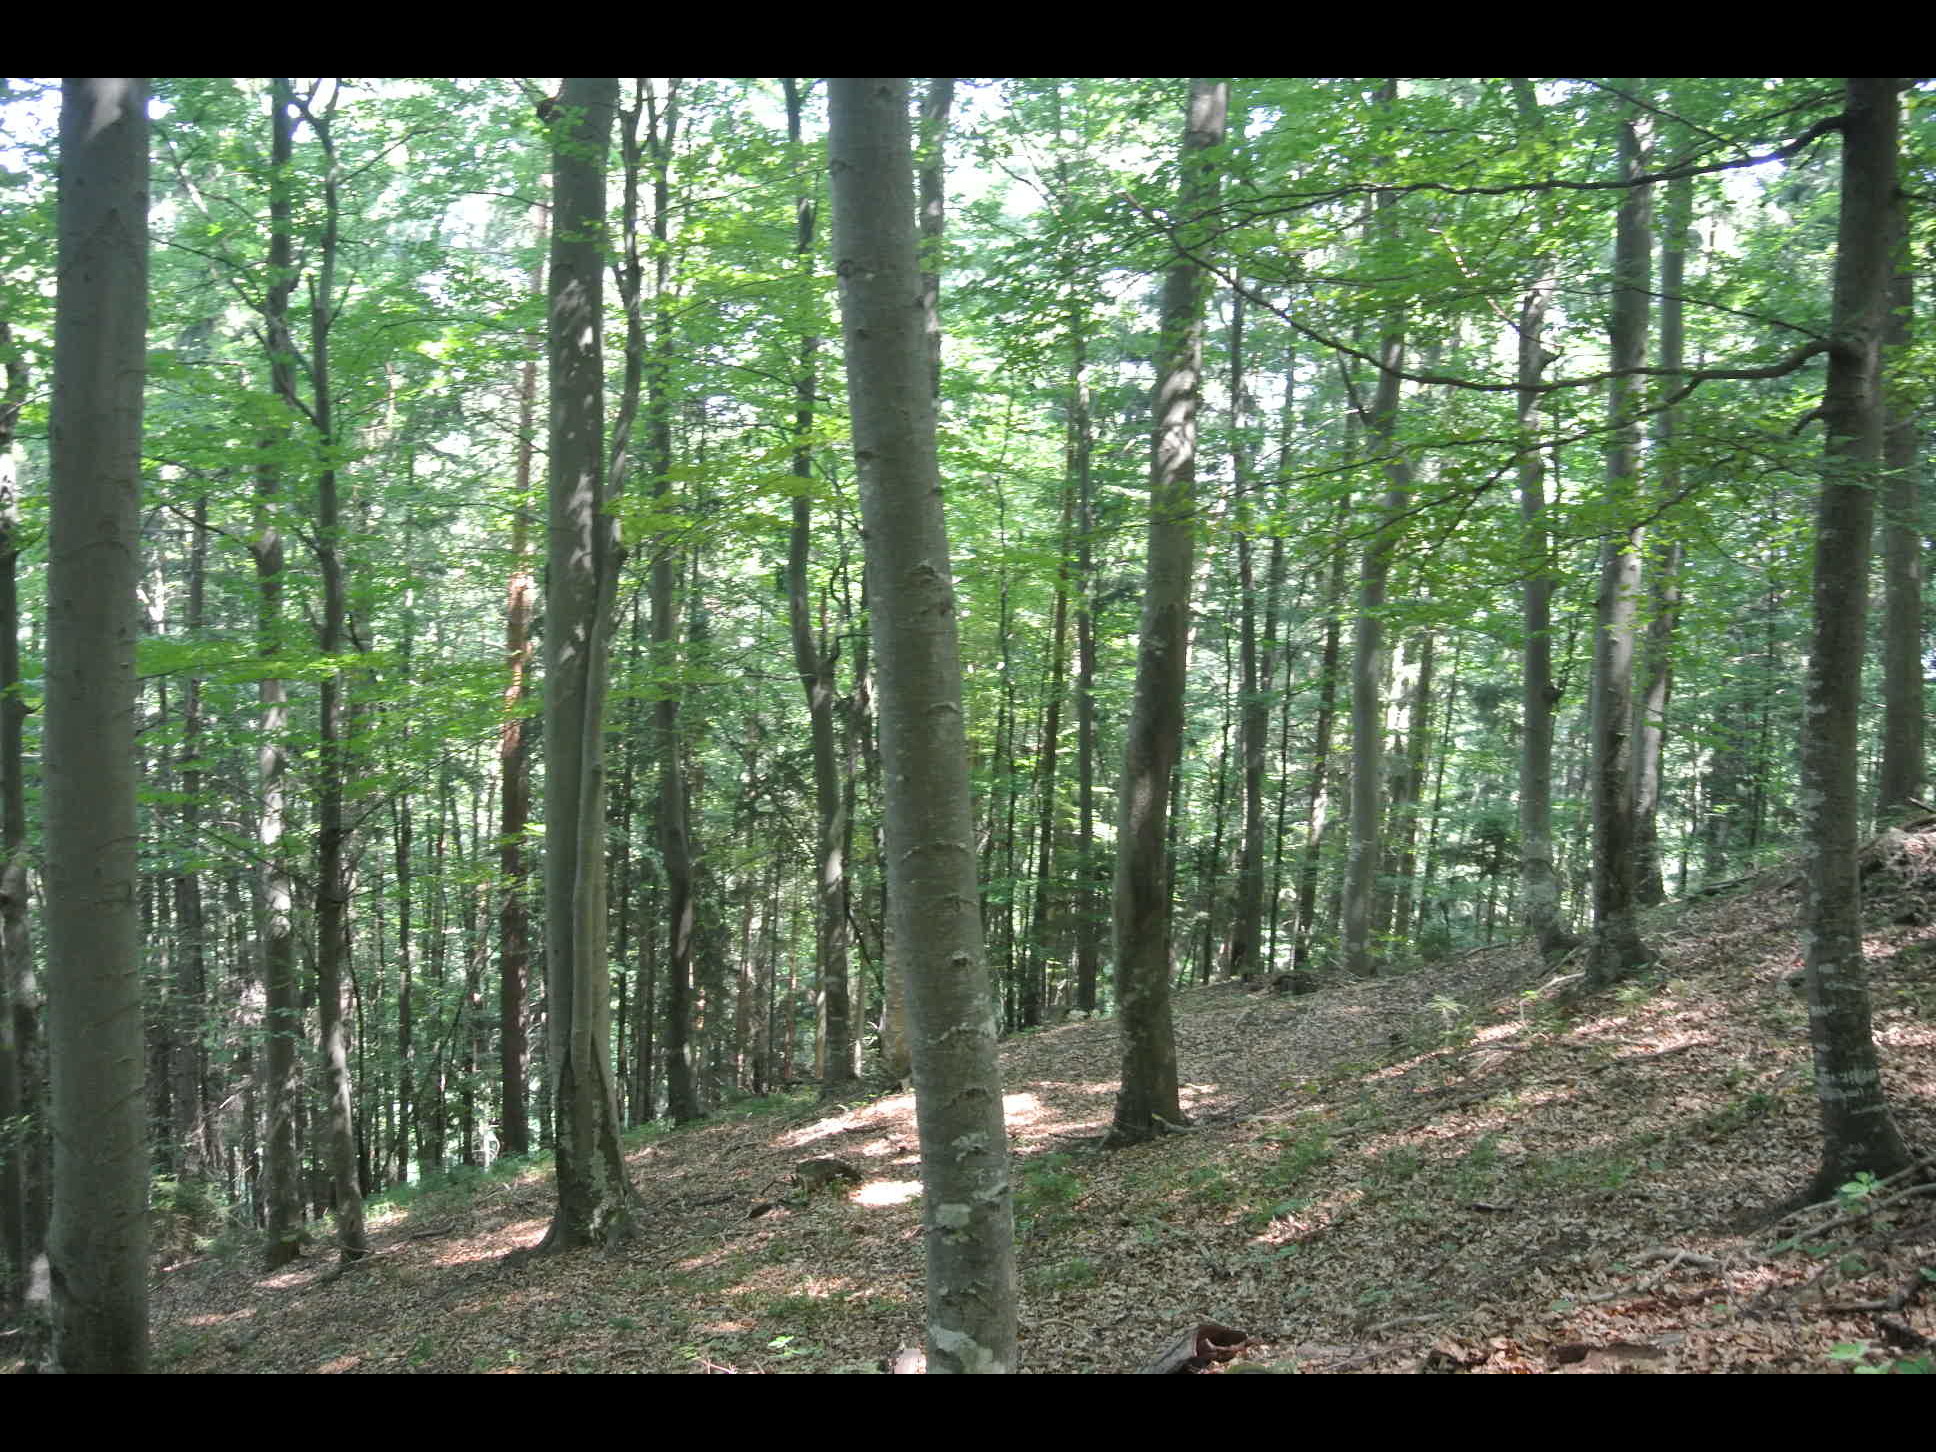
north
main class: Woodland
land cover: Broadleaved woodland
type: beech forest
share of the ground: > 75 %
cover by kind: broadleaved forest trees 80 %, coniferous forest trees 20 %
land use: Forestry
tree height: > 5 m
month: July
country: AT
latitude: 47.6553
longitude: 16.1409
